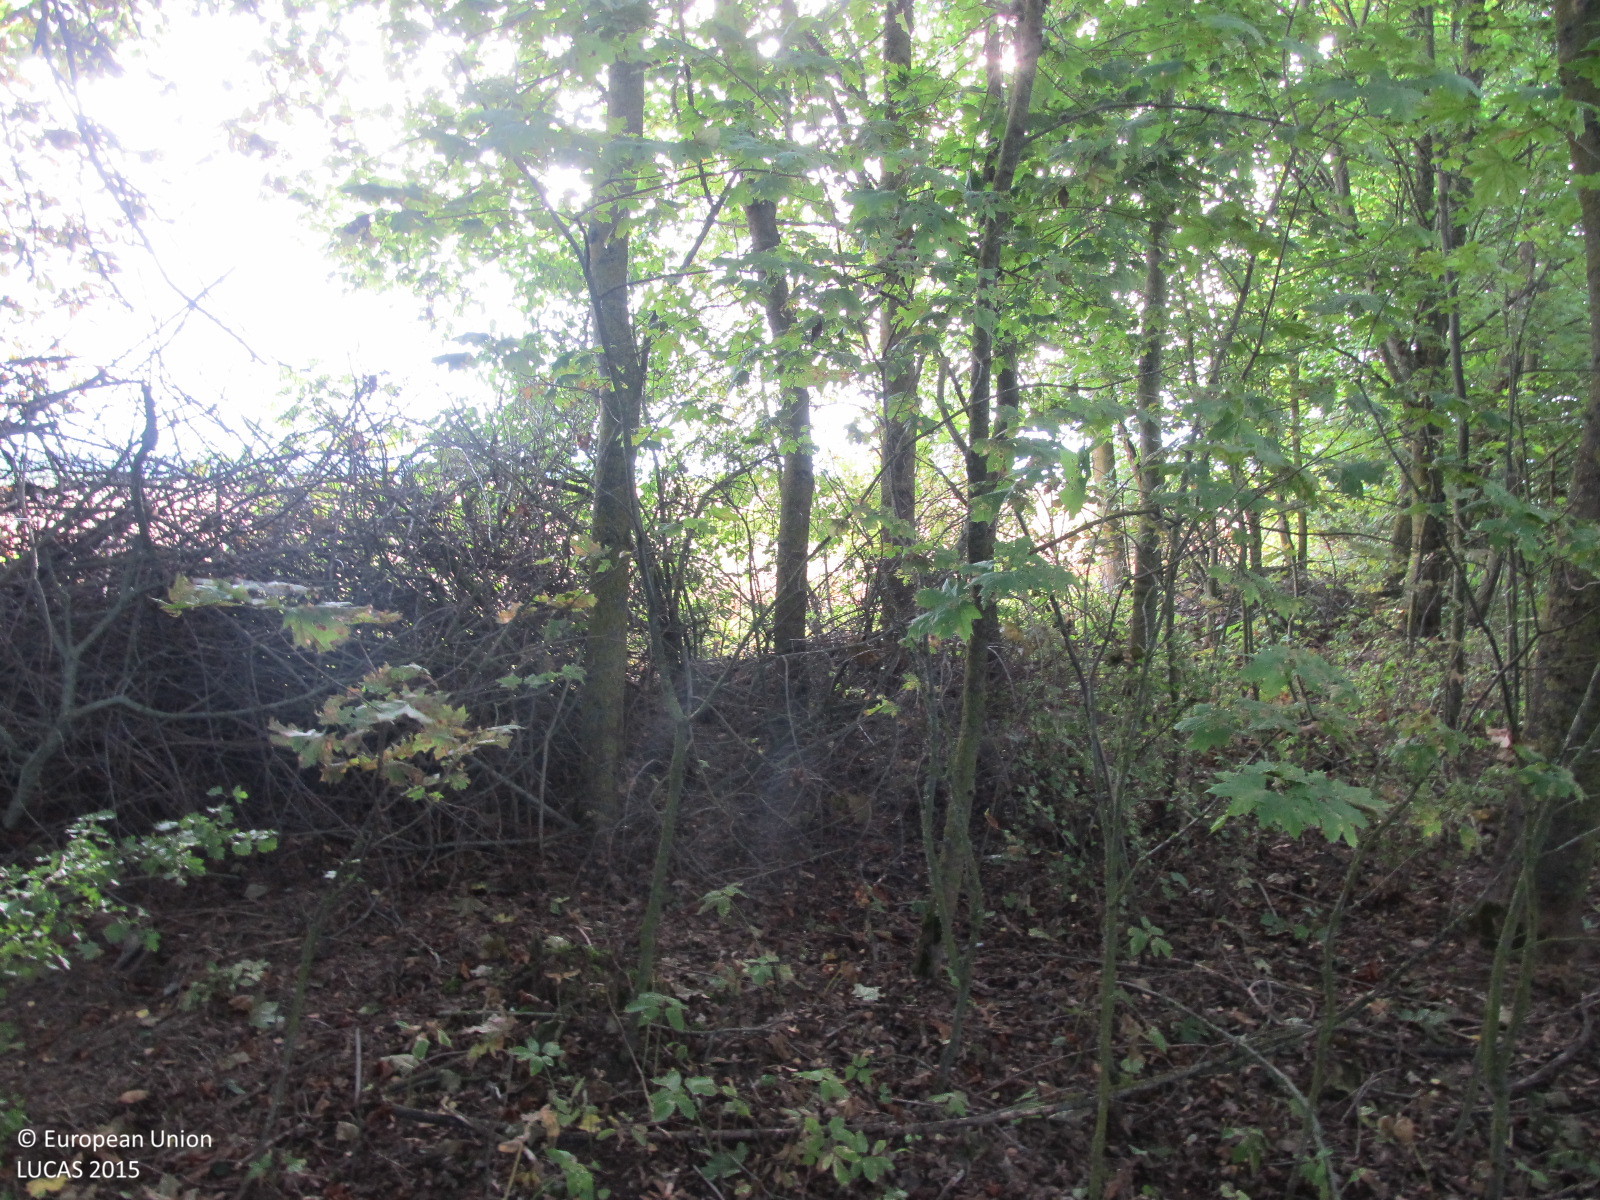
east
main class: Woodland
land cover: Broadleaved woodland
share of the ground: > 75 %
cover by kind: broadleaved forest trees 90 %, herbaceous plants 5 %, unconsolidated bare surface 5 %
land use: Forestry
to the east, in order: Broadleaved woodland; Common wheat; Electric lines; Common wheat; Paved roads, cycling and walking lanes; Other bare soil; Tracks; Grass margins; Electric lines; Barley
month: September
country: LT
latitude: 56.3324
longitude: 23.2859
